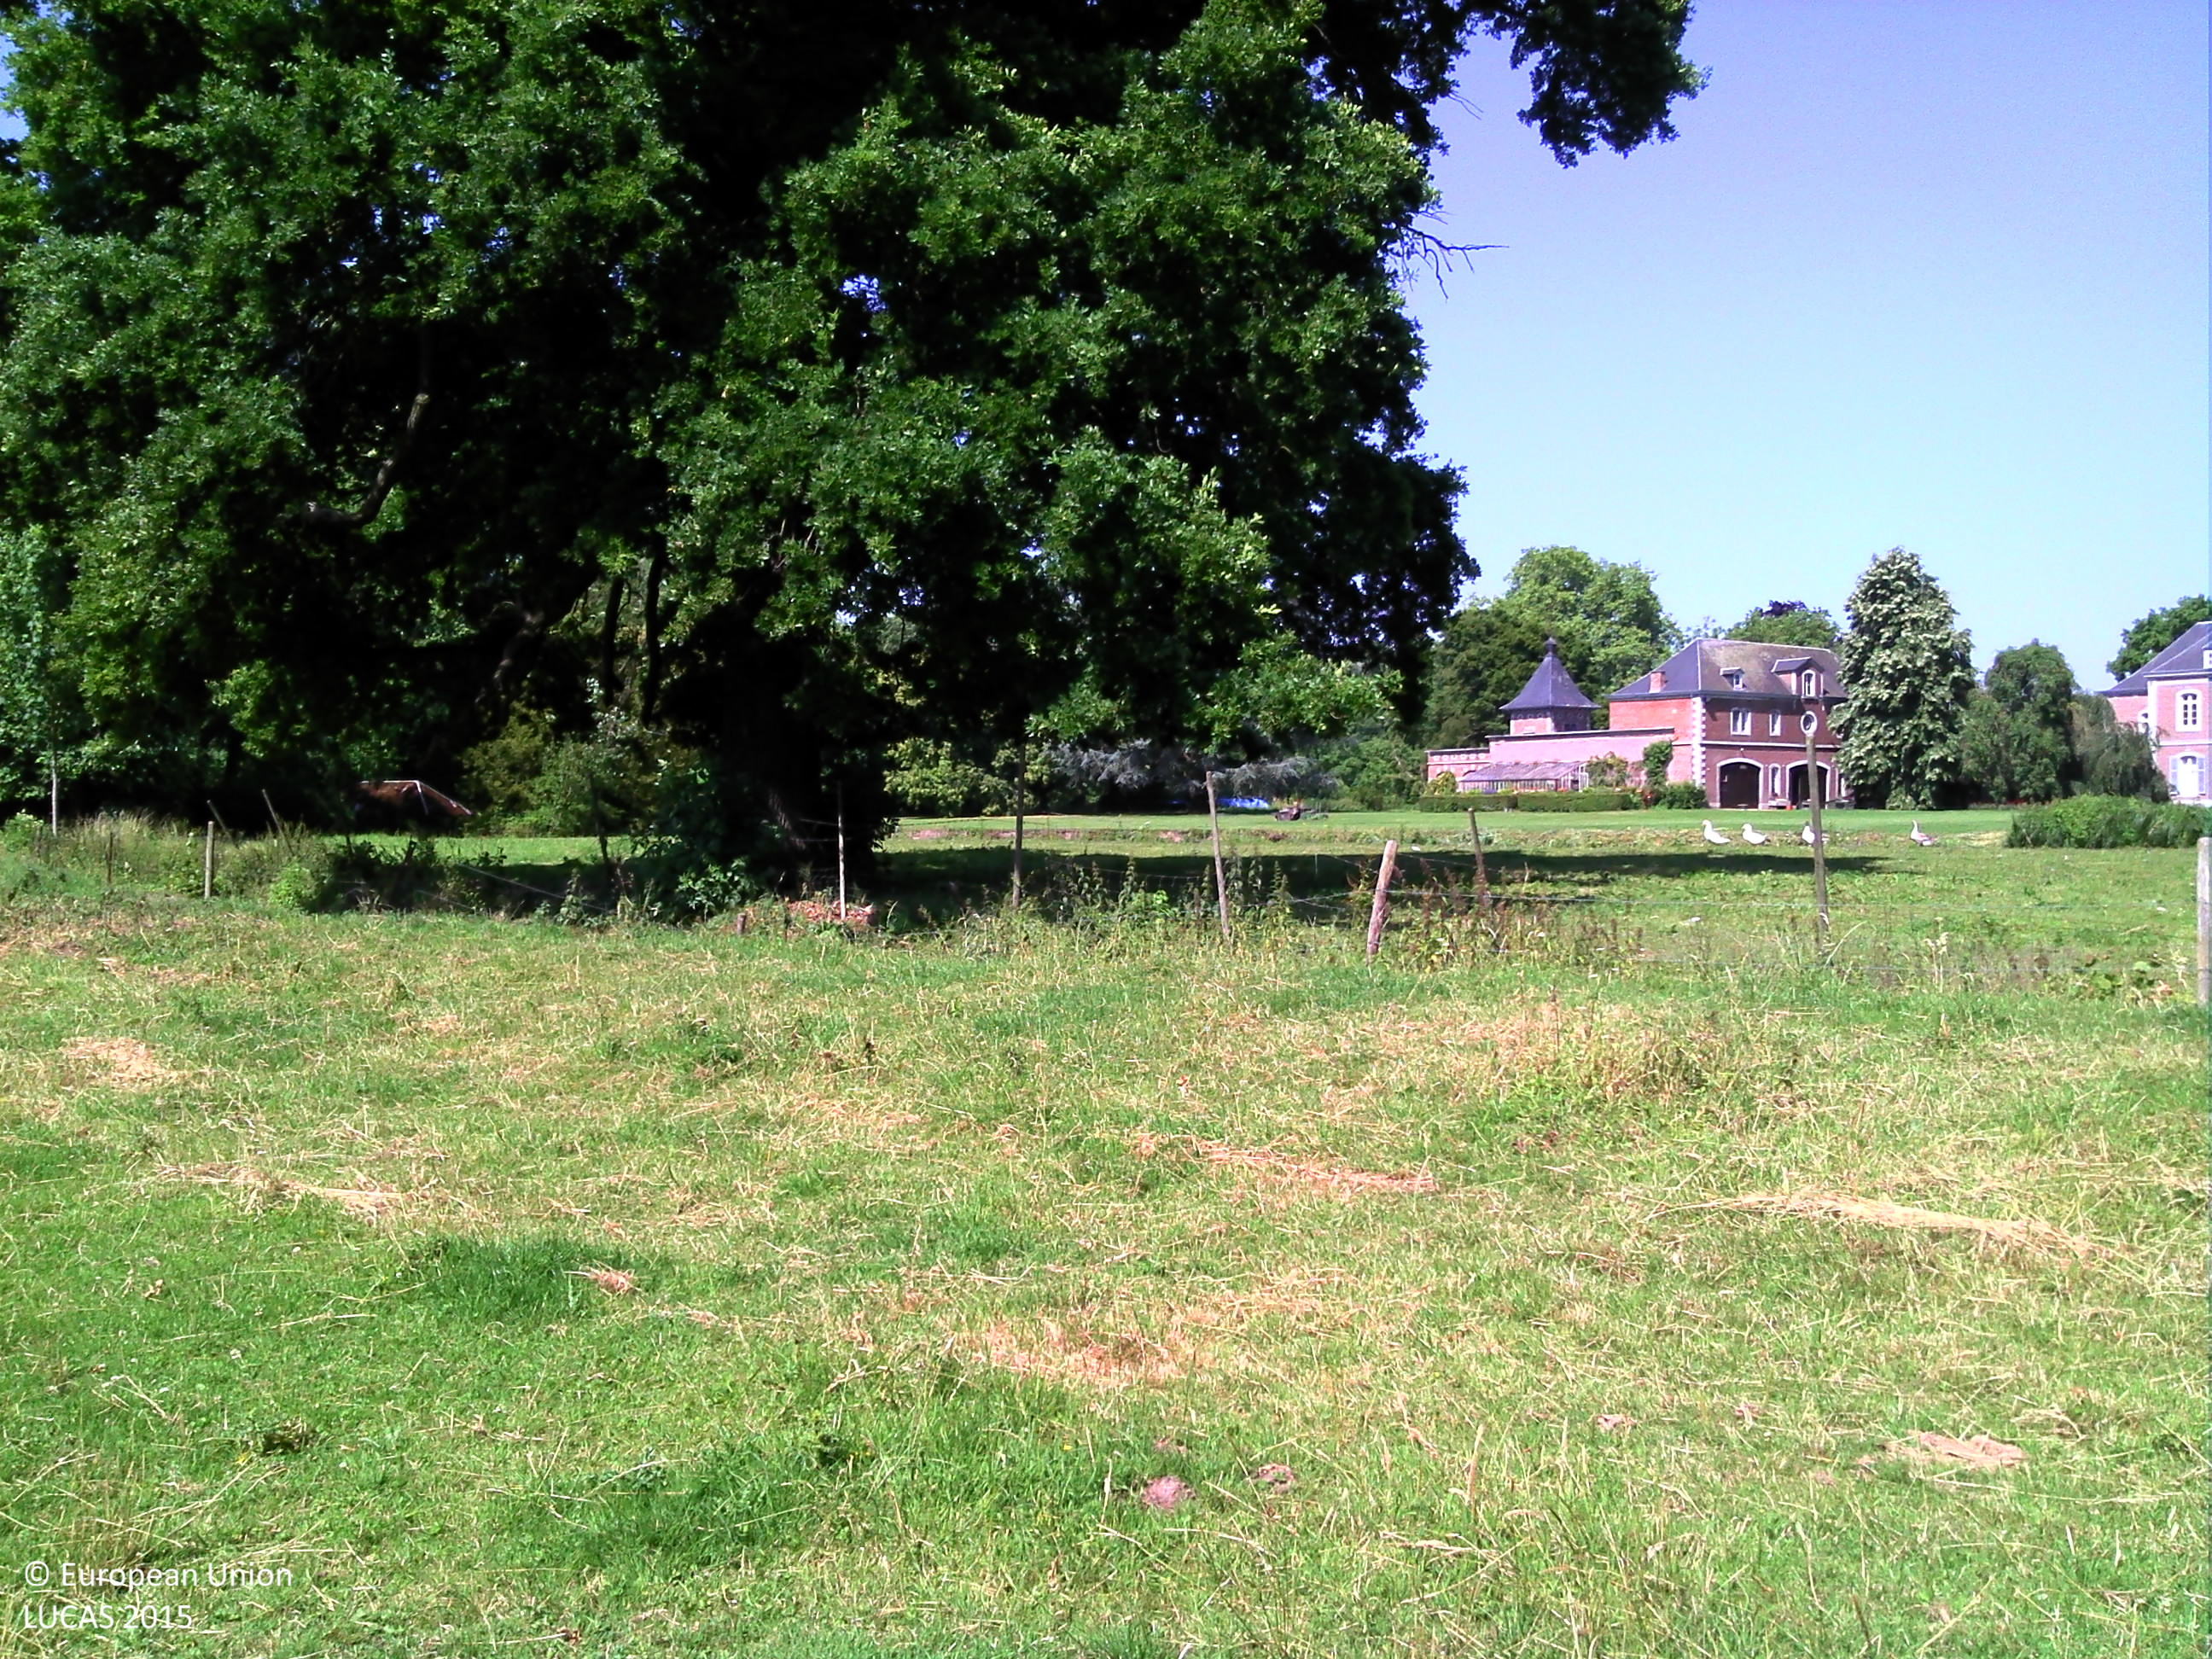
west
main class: Grassland
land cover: Grassland without tree/shrub cover
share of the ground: > 75 %
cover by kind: herbaceous plants 100 %
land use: Agriculture (excluding fallow land and kitchen gardens)
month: June
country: BE
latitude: 50.8391
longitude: 5.1835
